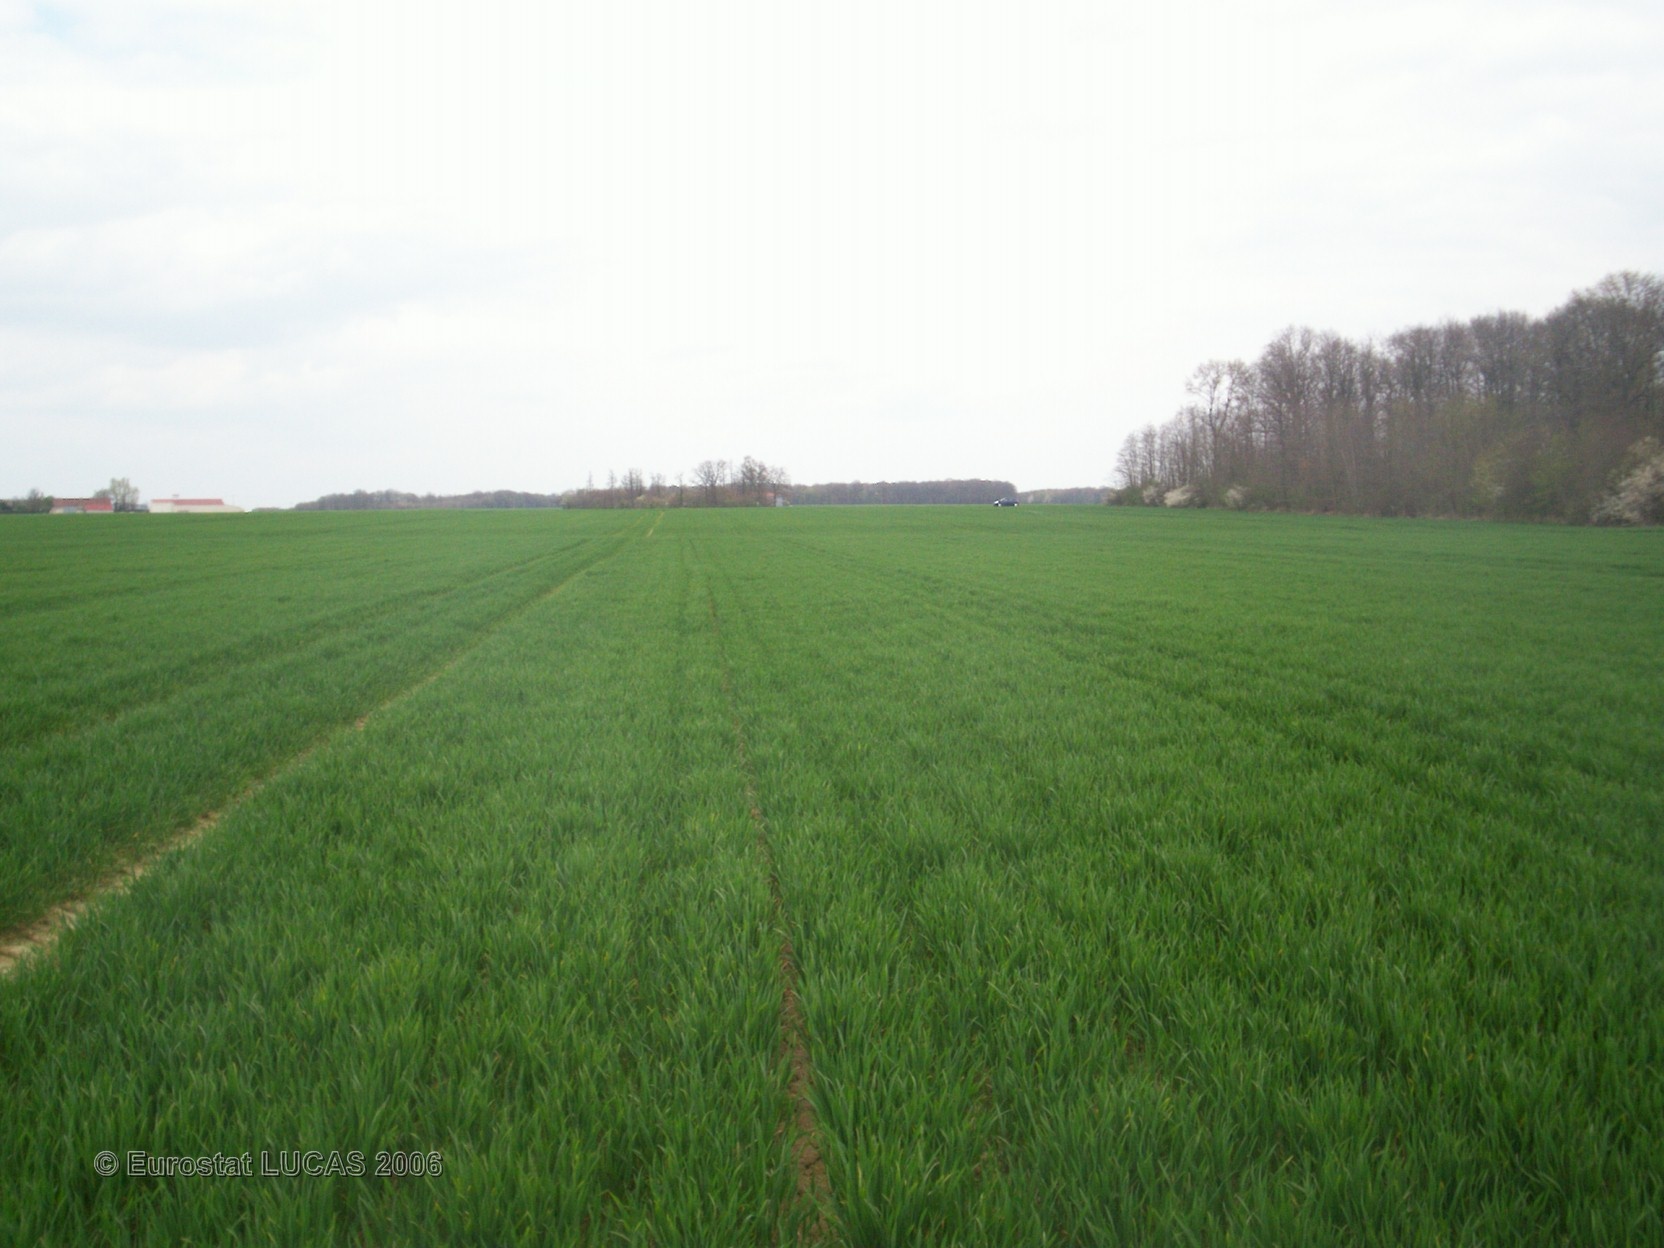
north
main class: Cropland
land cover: Common wheat
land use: Agriculture (excluding fallow land and kitchen gardens)
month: April
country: FR
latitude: 47.6776
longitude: 0.8297
